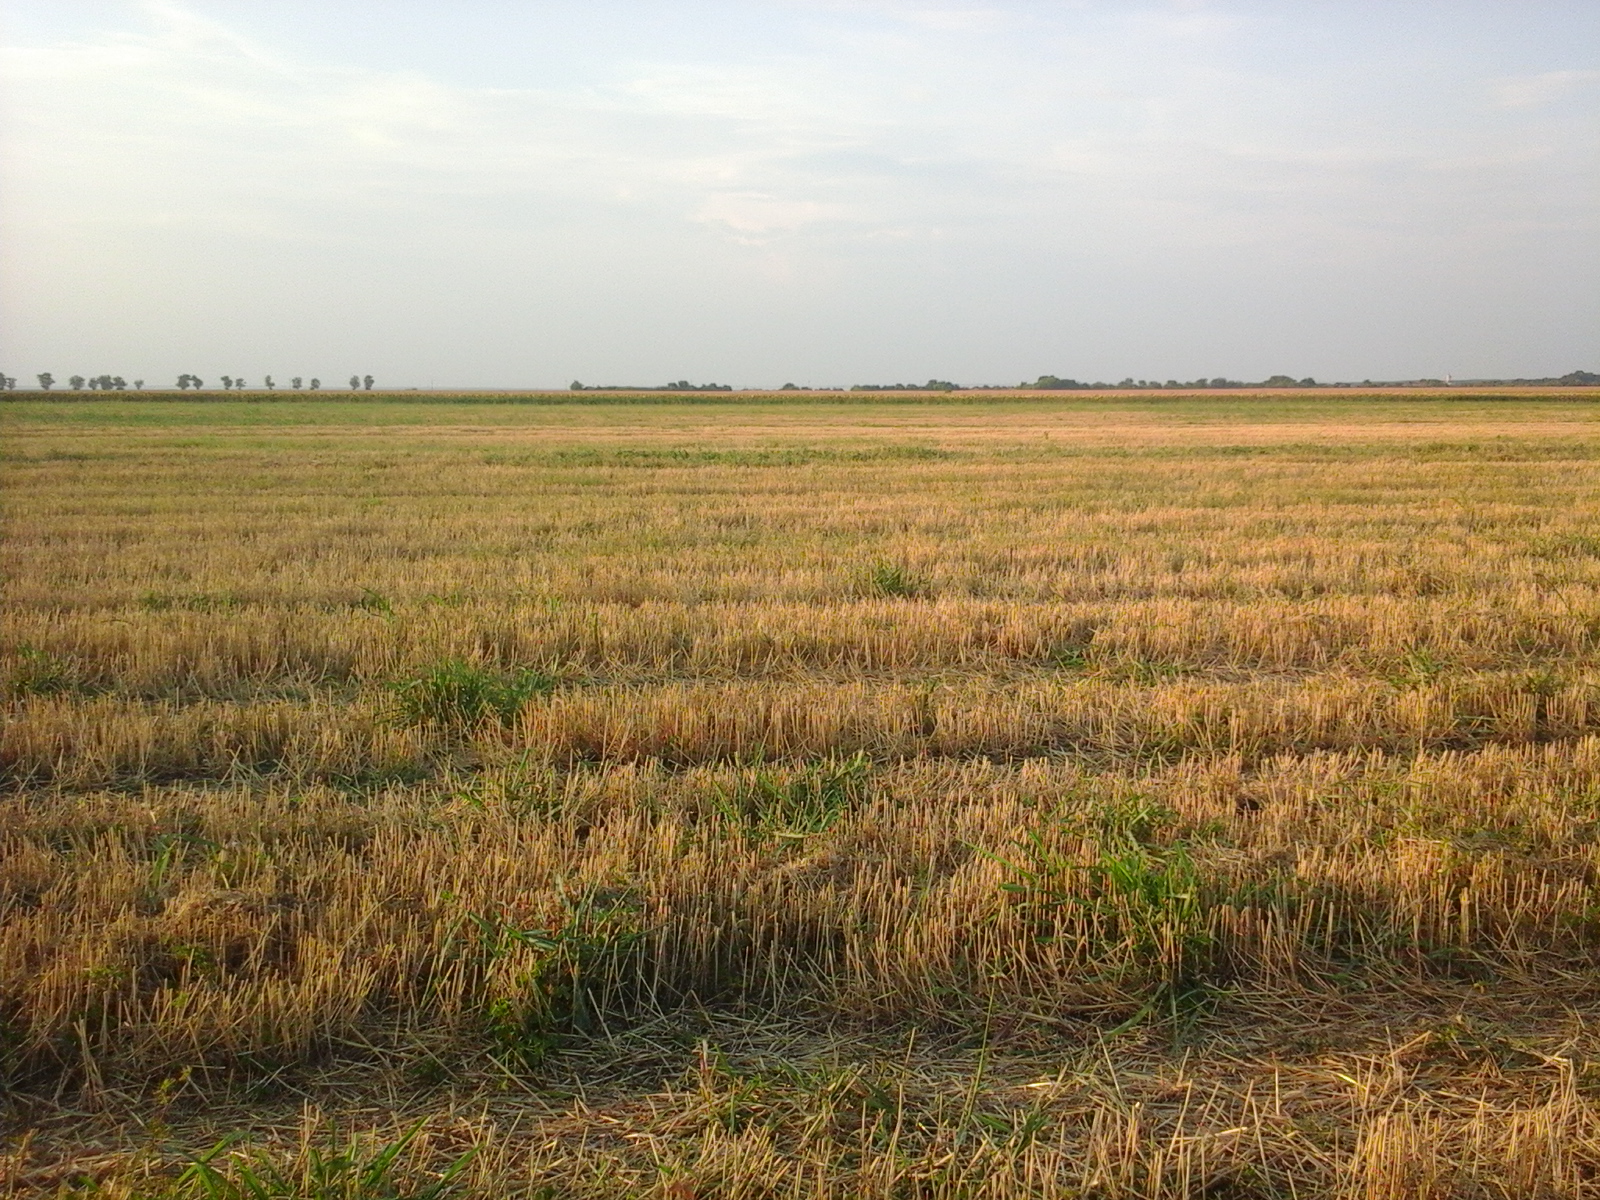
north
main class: Cropland
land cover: Common wheat
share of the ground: 50 - 75 %
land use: Agriculture (excluding fallow land and kitchen gardens)
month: August
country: RO
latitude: 44.0010
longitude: 23.5815
